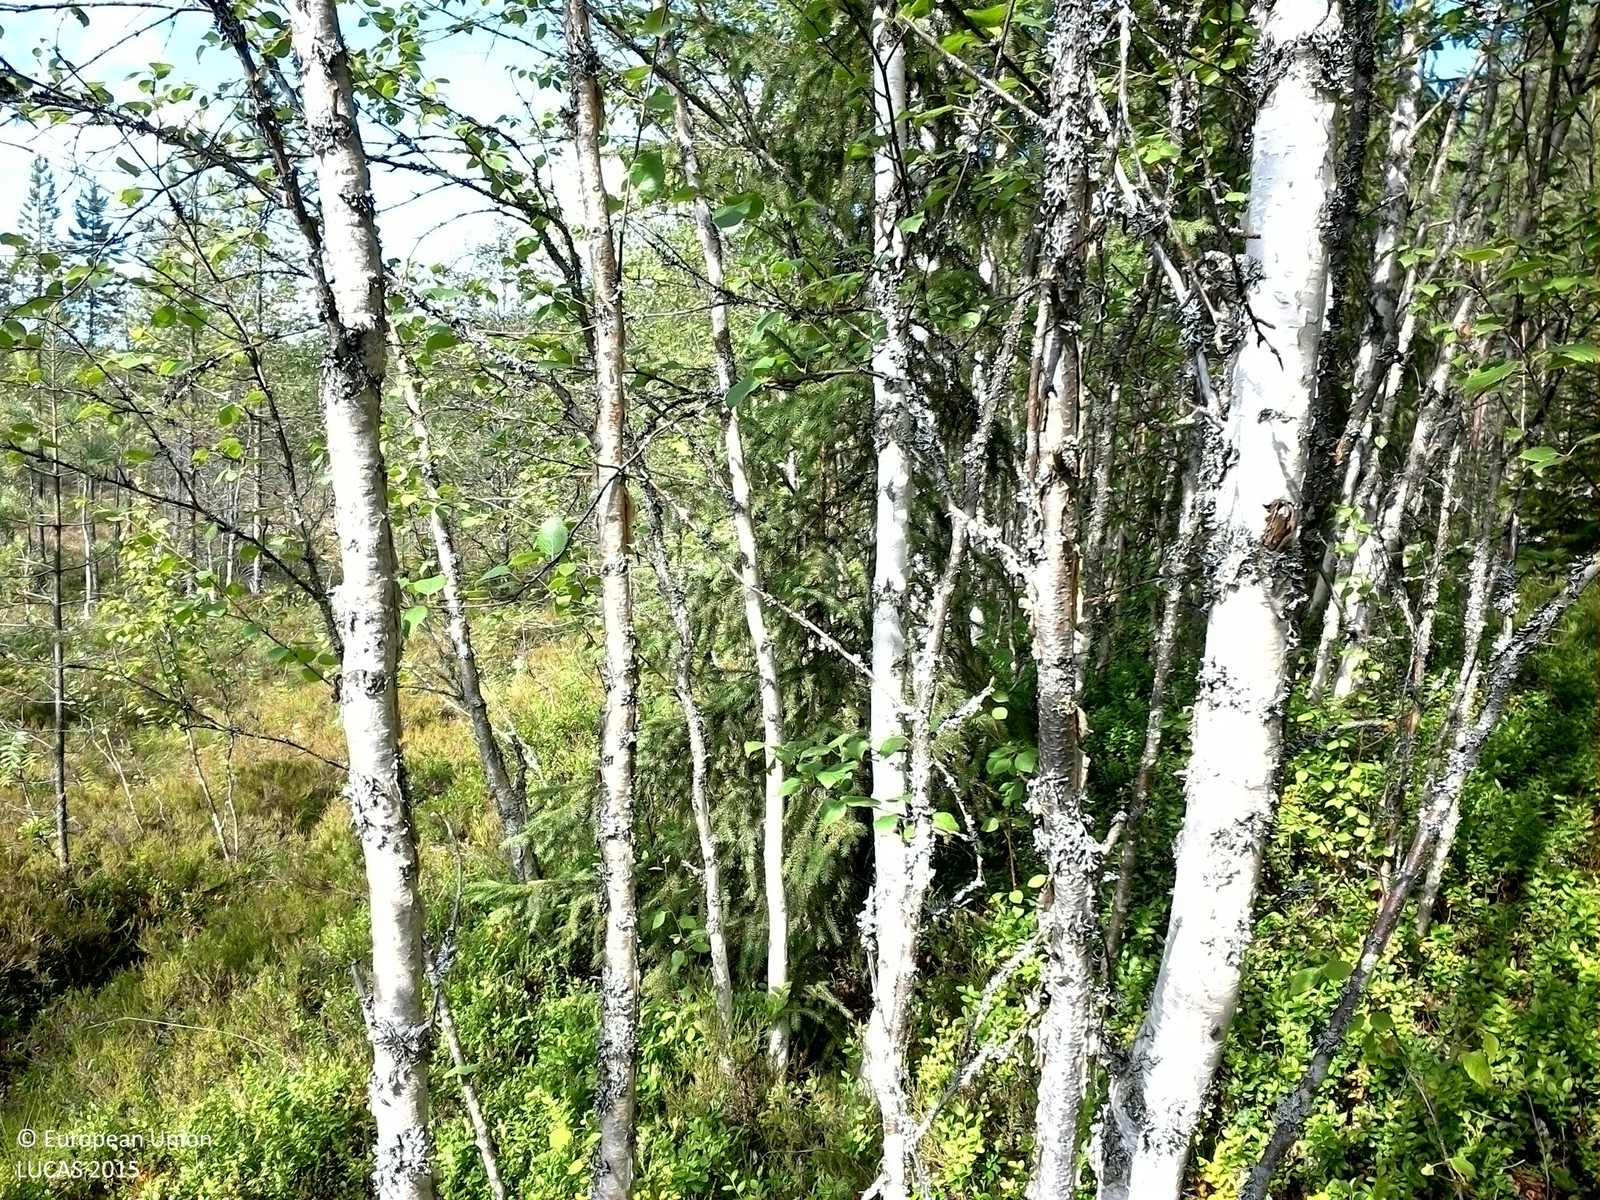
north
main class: Woodland
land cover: Pine dominated coniferous woodland
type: boreal forest
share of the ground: 50 - 75 %
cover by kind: coniferous forest trees 55 %, shrubs 25 %, broadleaved forest trees 10 %, lichens and mosses 10 %
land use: Forestry
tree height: > 5 m
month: August
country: SE
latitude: 63.7944
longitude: 16.4874
